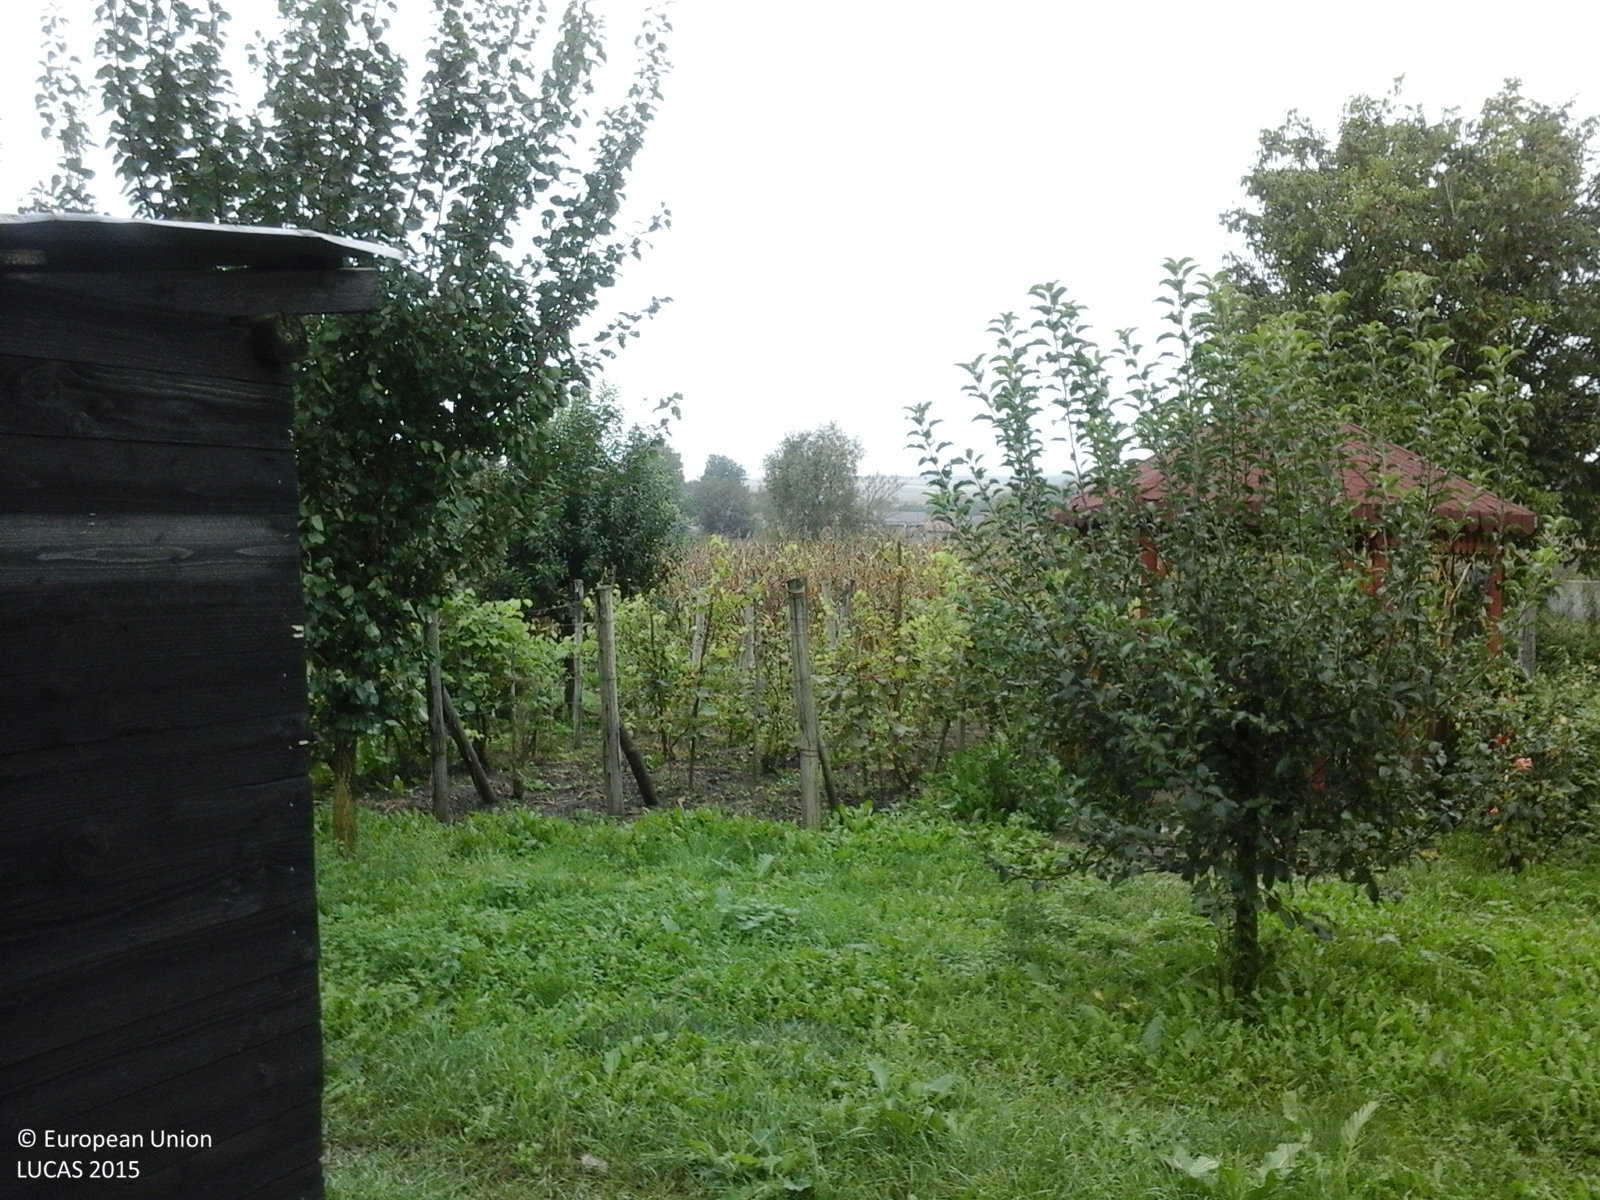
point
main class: Cropland
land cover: Maize
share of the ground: > 75 %
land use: Agriculture (excluding fallow land and kitchen gardens)
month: October
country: RO
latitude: 46.6865
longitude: 24.4032
